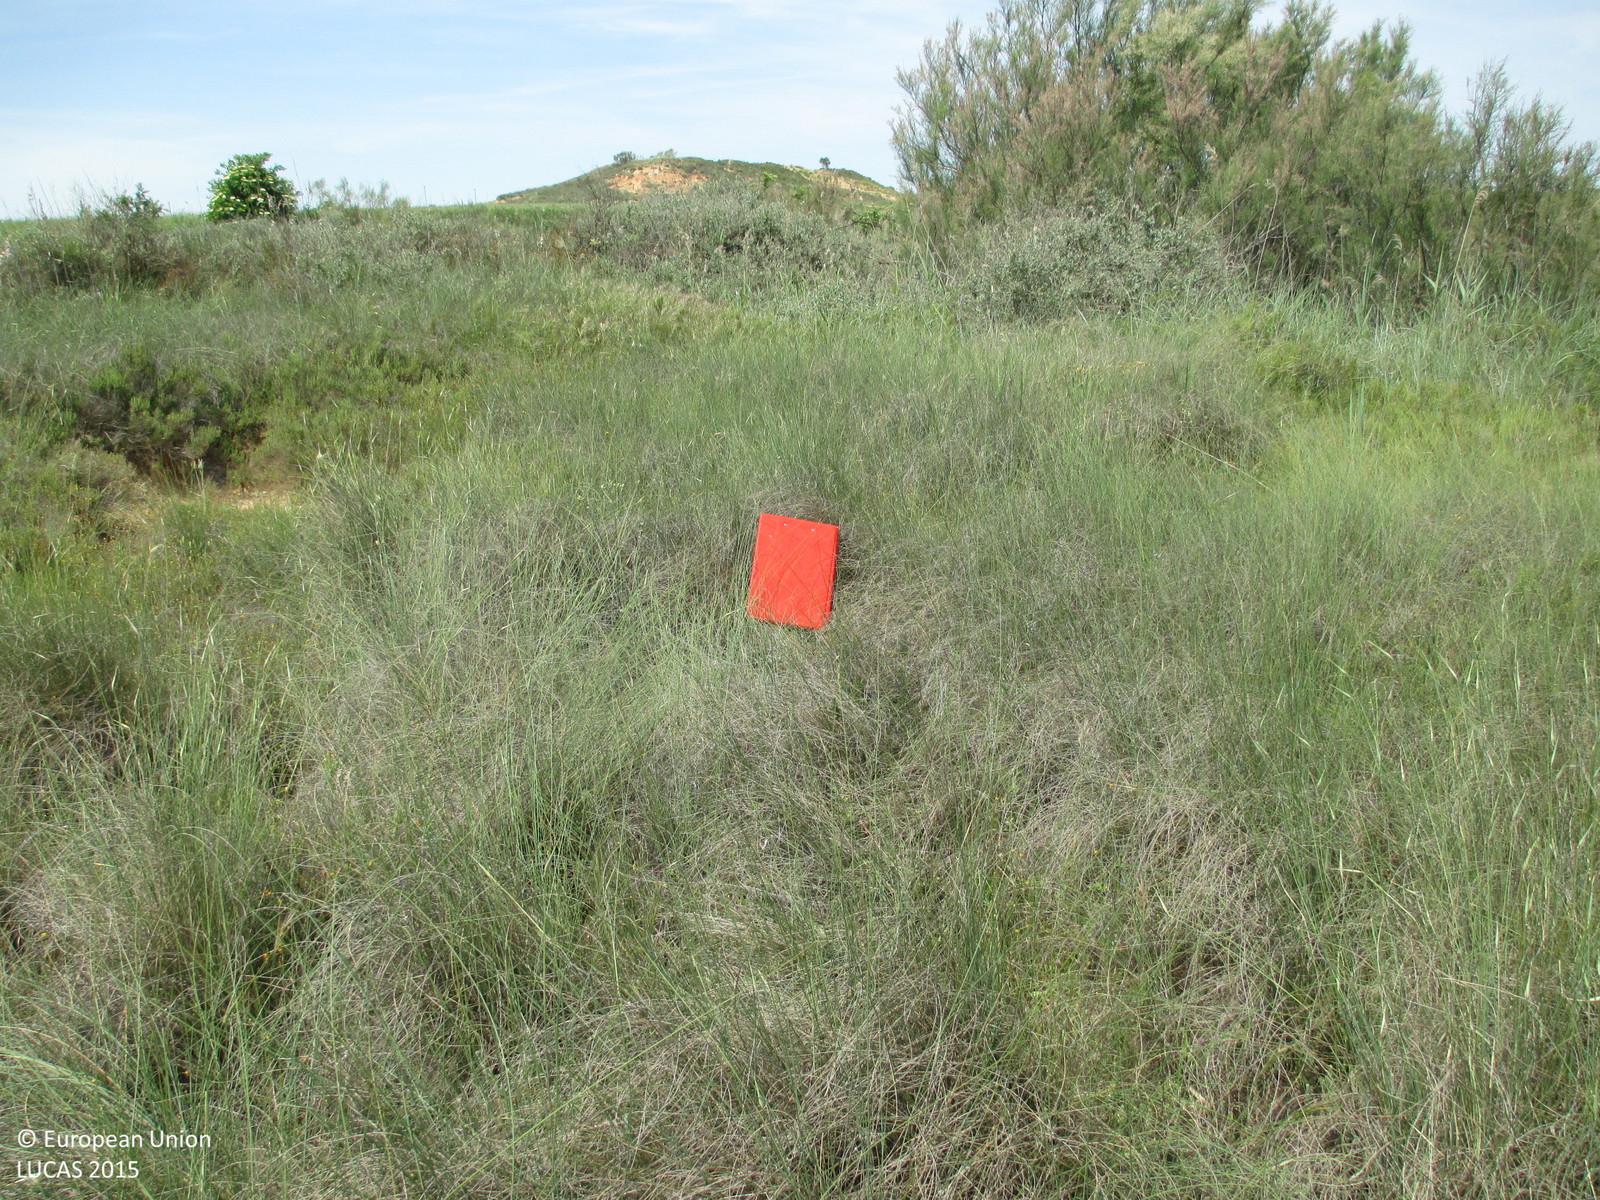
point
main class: Shrubland
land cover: Shrubland without tree cover
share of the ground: > 75 %
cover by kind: shrubs 95 %, herbaceous plants 5 %
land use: Semi-natural and natural areas not in use
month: May
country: ES
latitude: 41.8836
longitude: -0.3718
